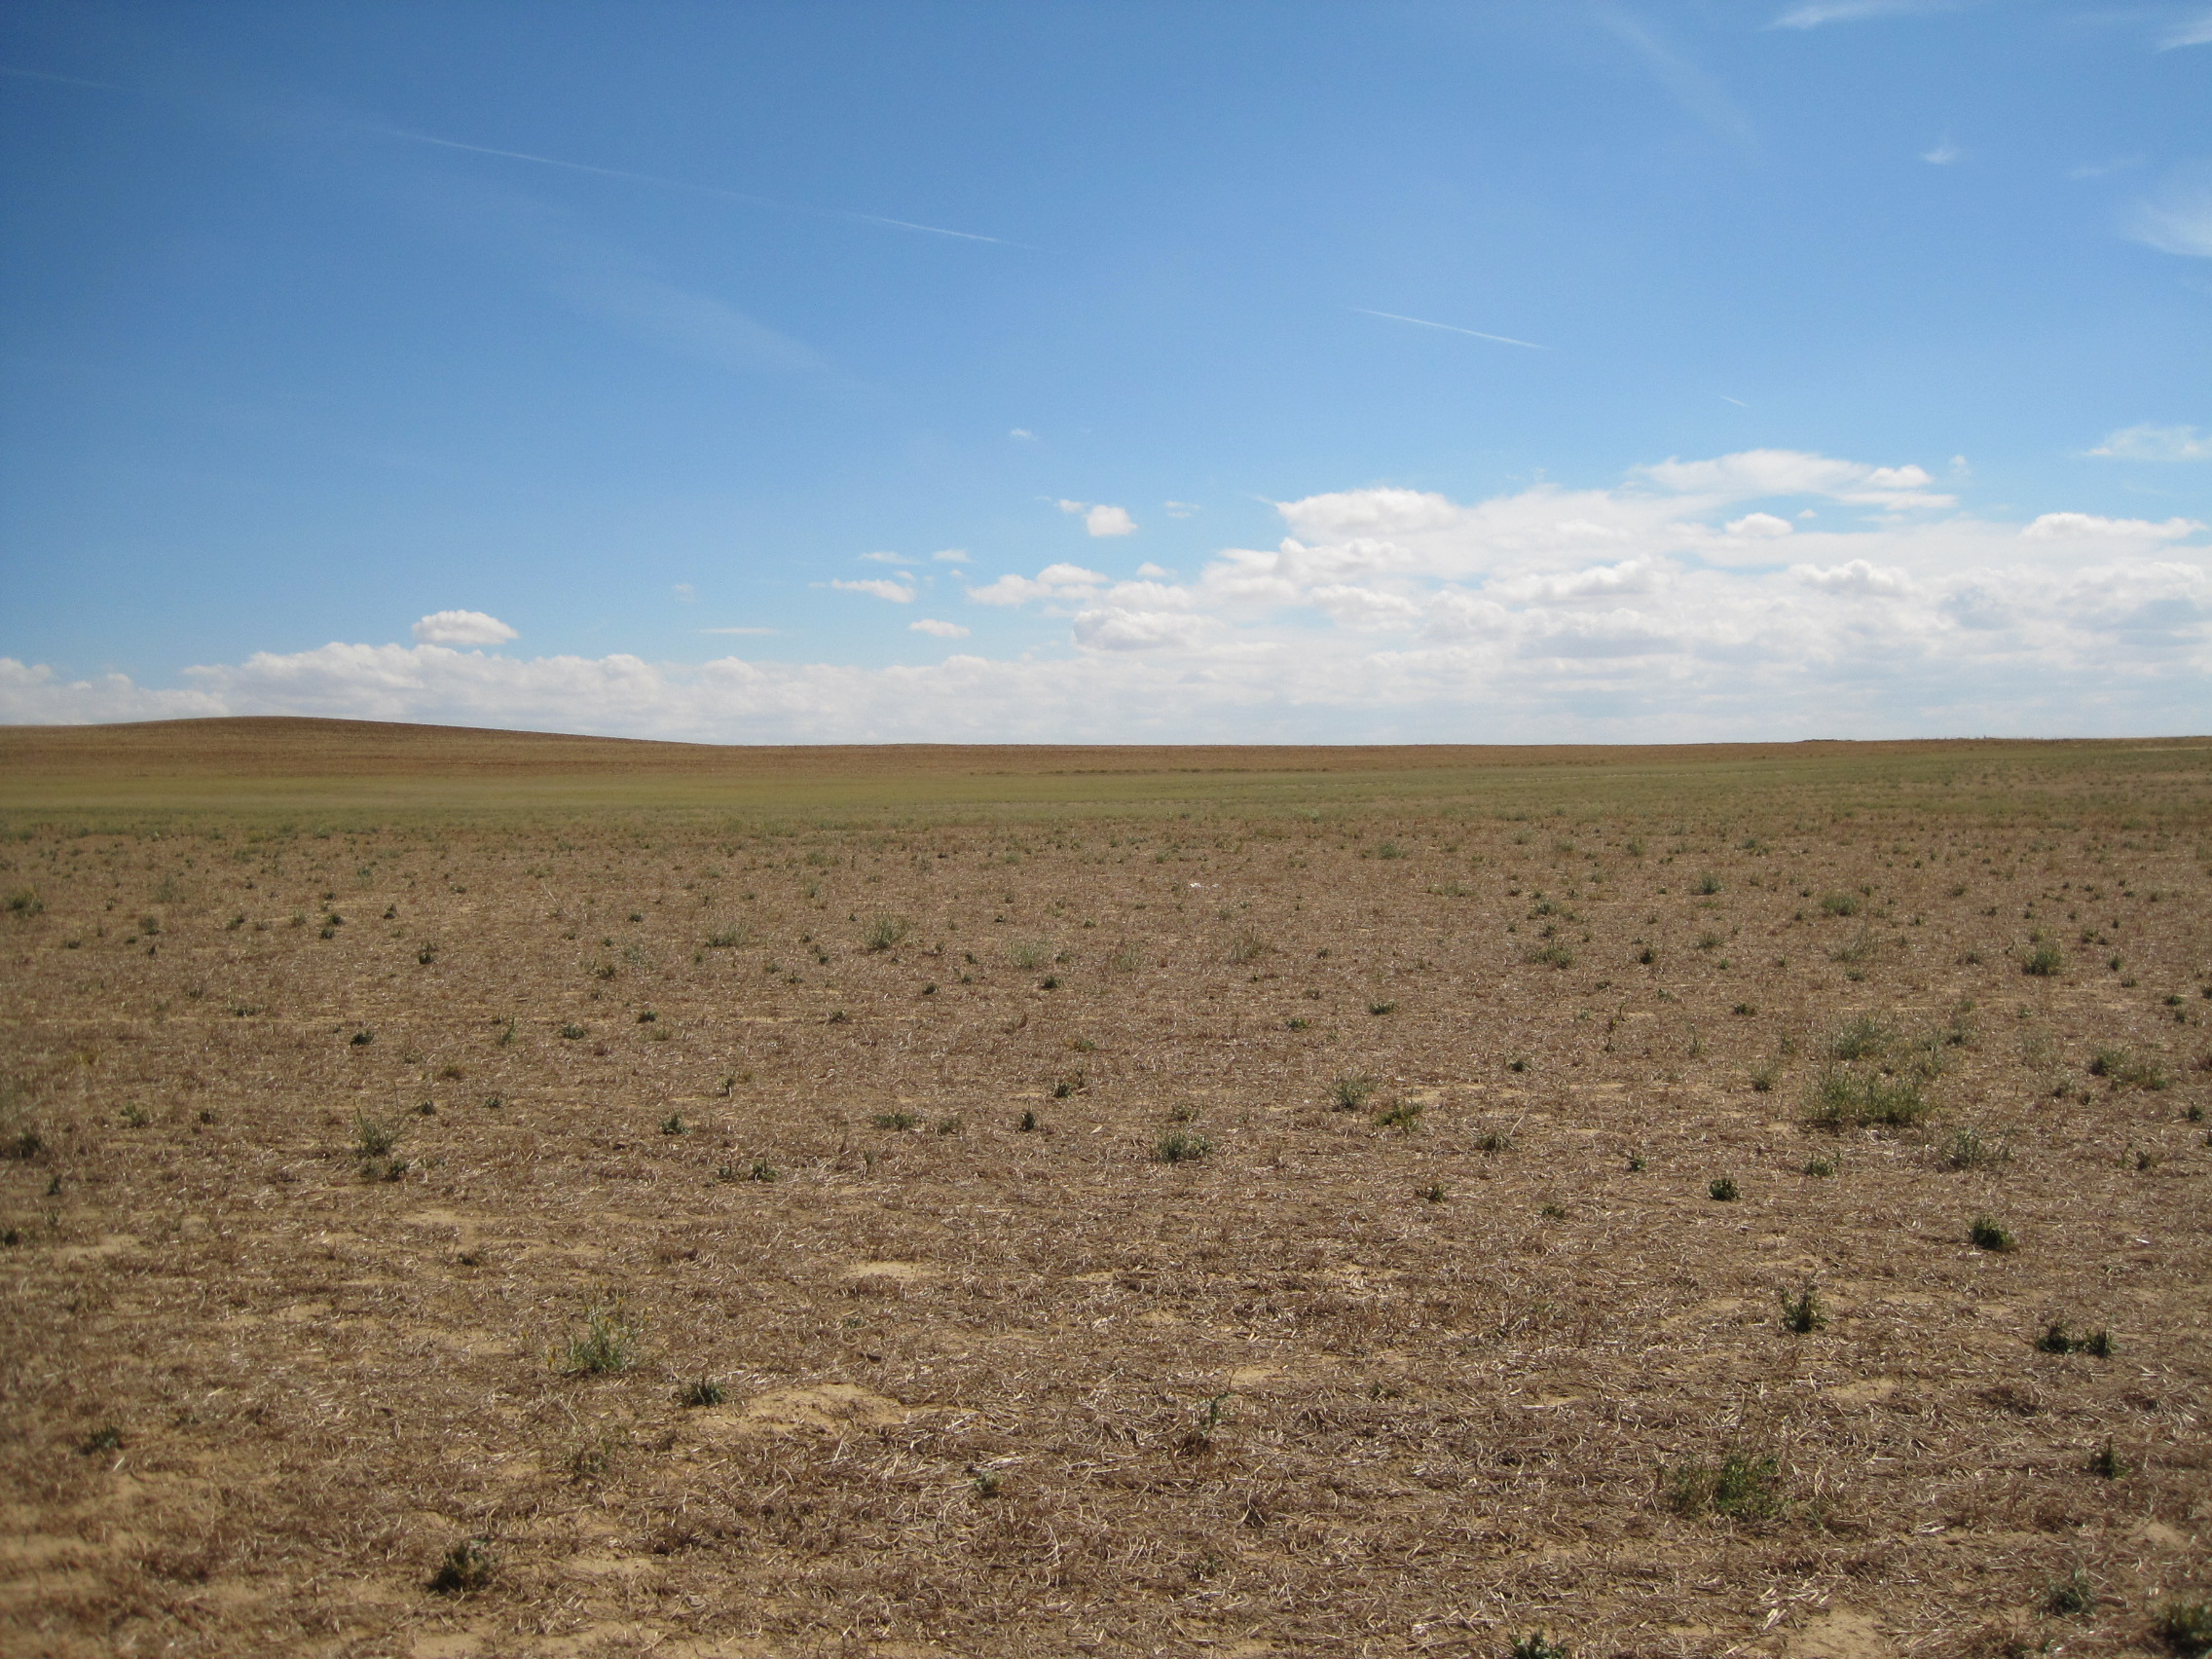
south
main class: Cropland
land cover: Dry pulses
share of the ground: < 10 %
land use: Agriculture (excluding fallow land and kitchen gardens)
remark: Harvested field
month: July
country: ES
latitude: 41.9792
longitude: -5.1797
